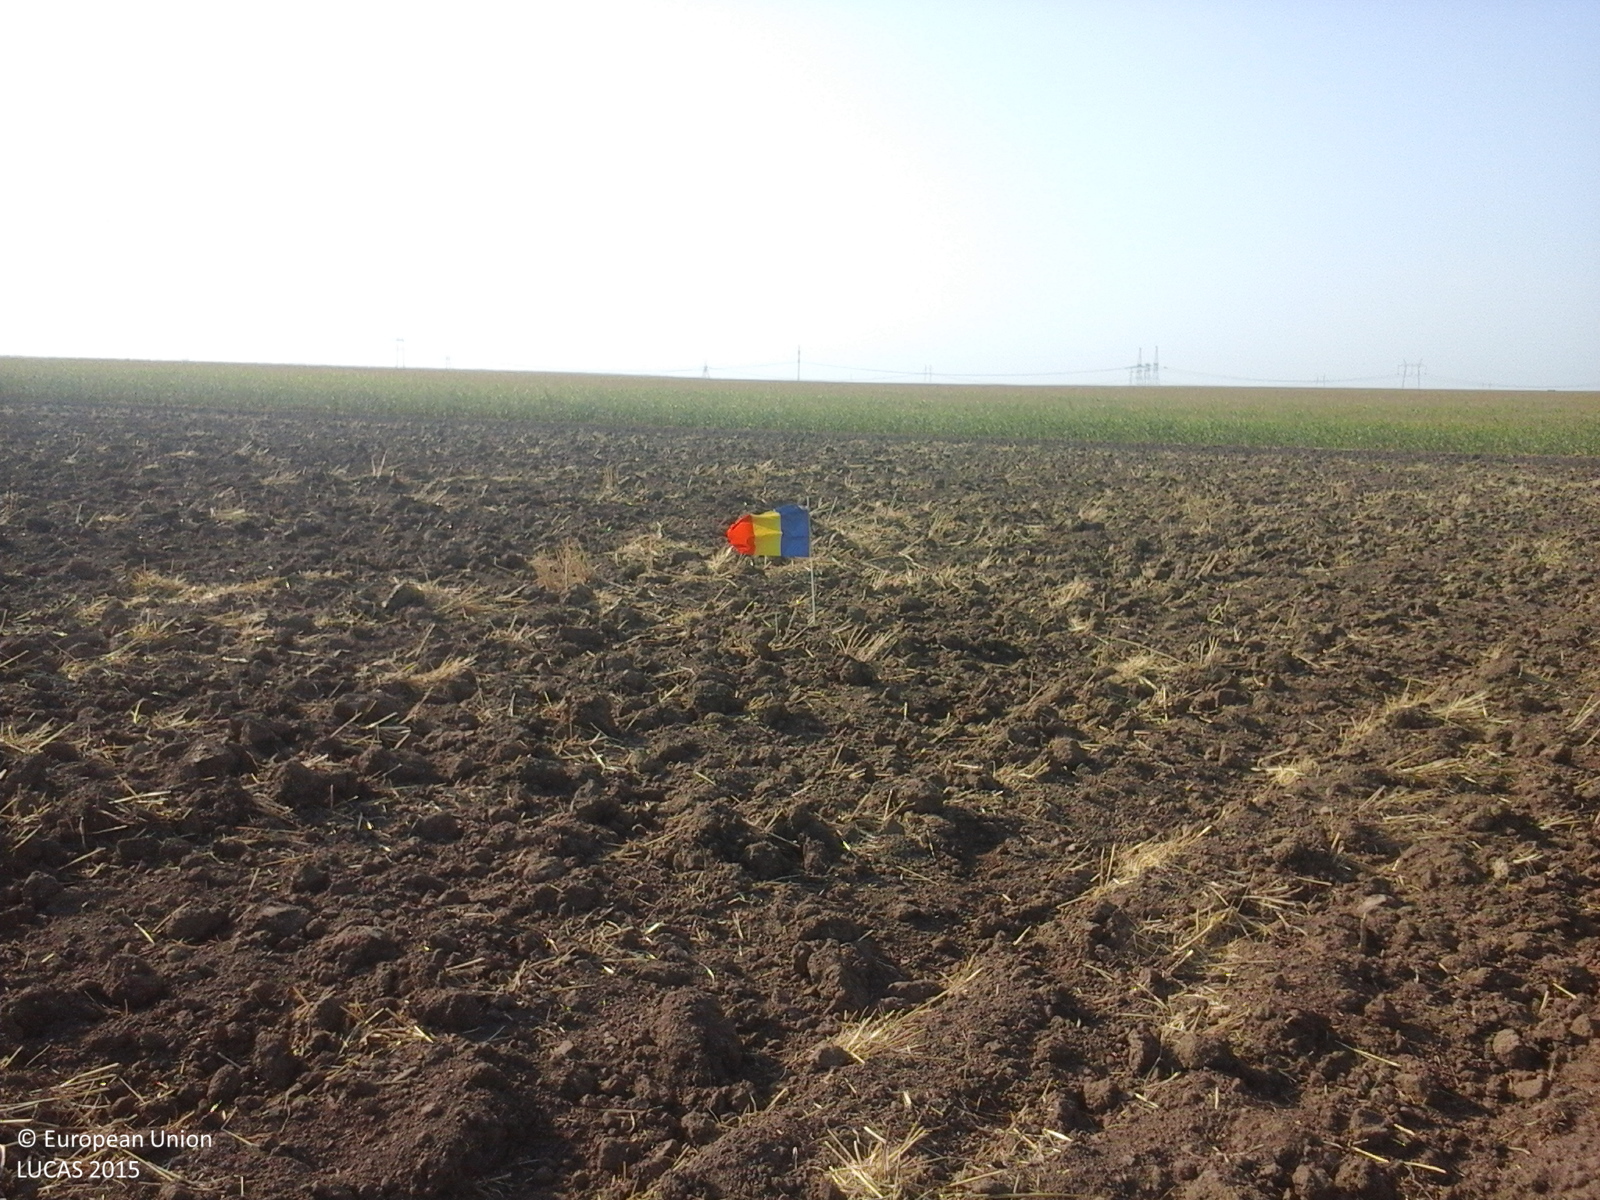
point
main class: Cropland
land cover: Common wheat
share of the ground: < 10 %
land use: Agriculture (excluding fallow land and kitchen gardens)
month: August
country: RO
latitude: 44.0318
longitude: 28.0079
